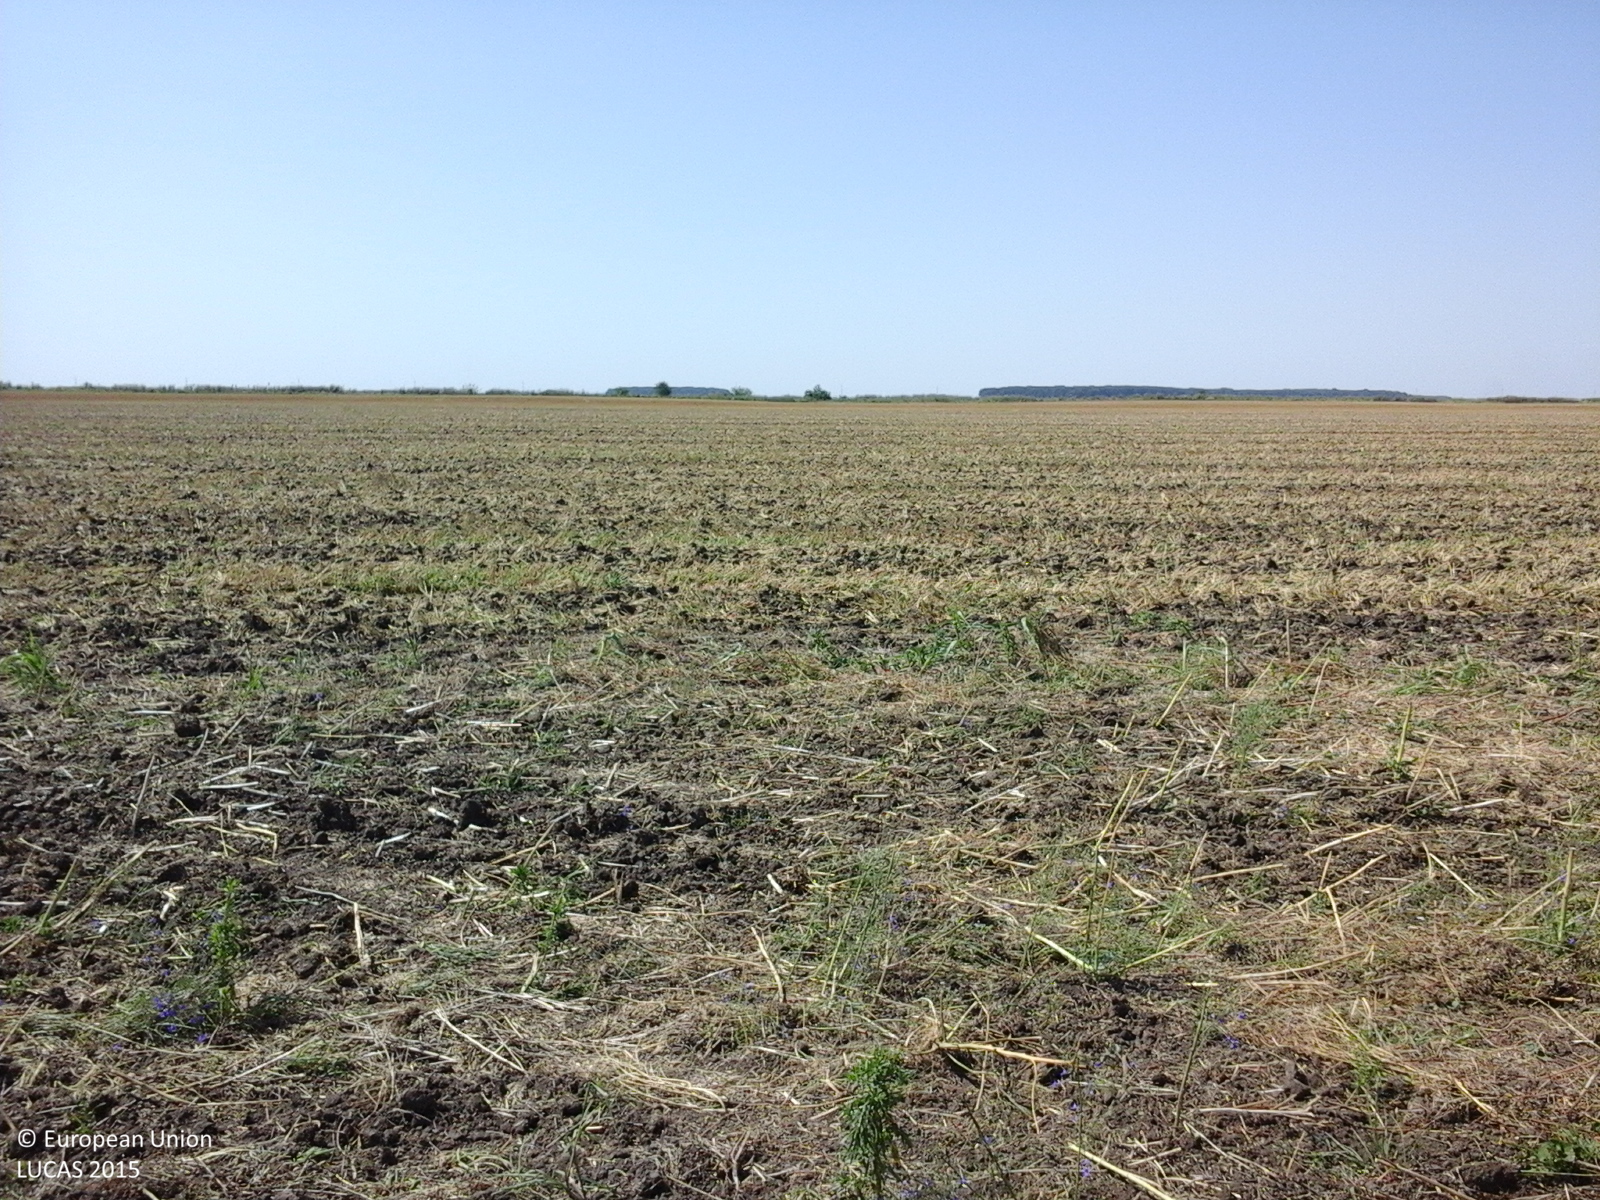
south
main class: Cropland
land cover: Rape and turnip rape
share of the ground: < 10 %
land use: Agriculture (excluding fallow land and kitchen gardens)
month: July
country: RO
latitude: 44.4402
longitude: 26.4600
